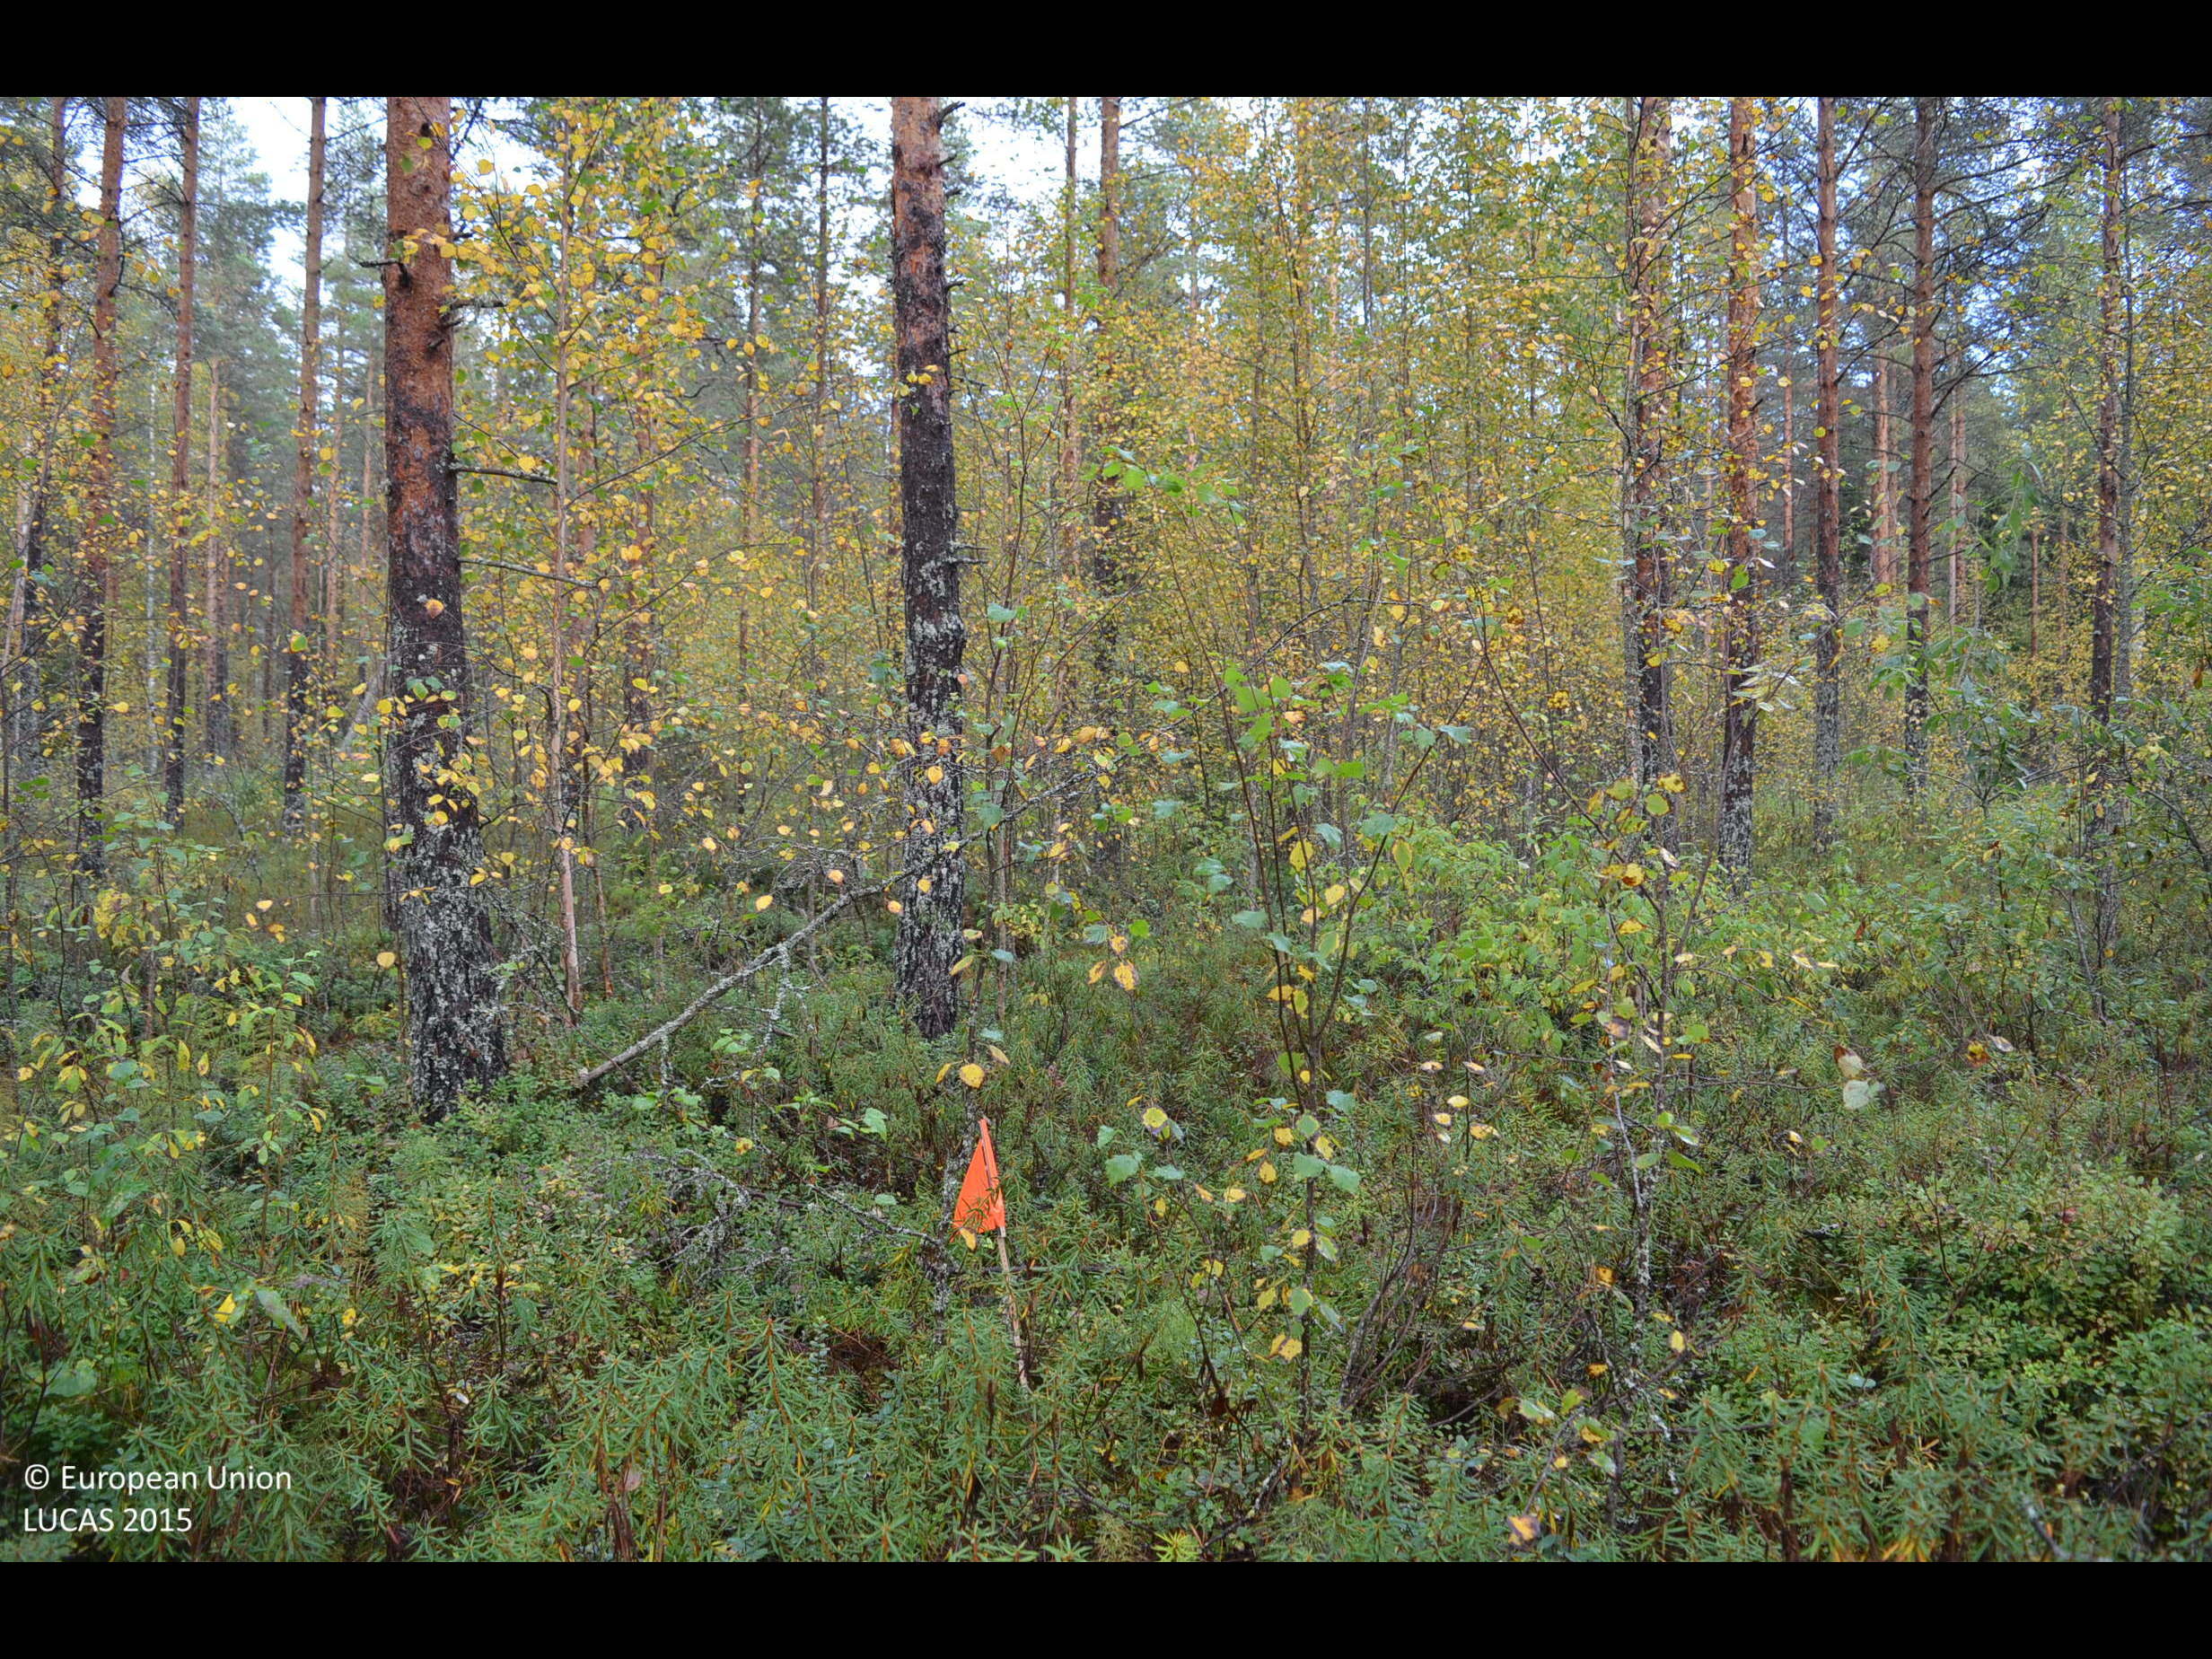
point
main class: Woodland
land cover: Pine dominated mixed woodland
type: boreal forest
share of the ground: > 75 %
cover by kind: coniferous forest trees 55 %, shrubs 25 %, broadleaved forest trees 20 %
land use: Forestry
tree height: > 5 m
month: September
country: FI
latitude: 62.9135
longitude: 23.9536
